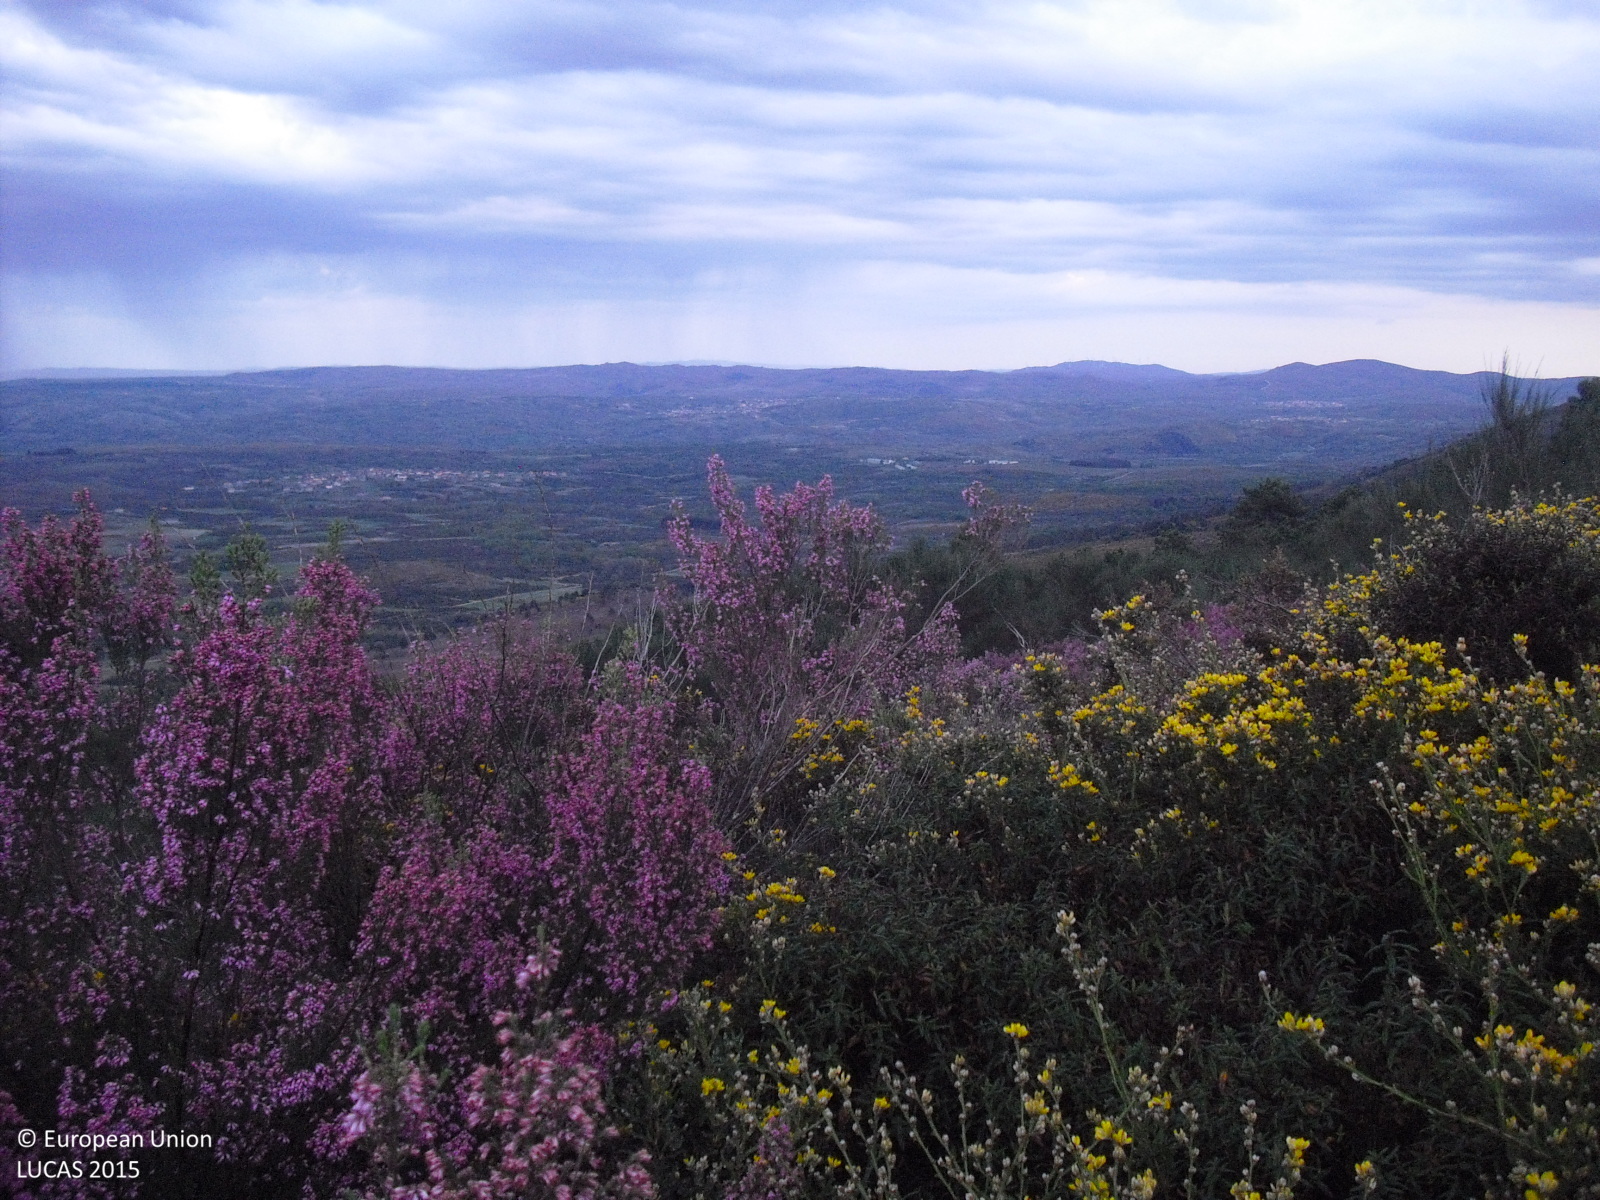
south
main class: Shrubland
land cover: Shrubland without tree cover
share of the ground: > 75 %
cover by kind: shrubs 70 %, herbaceous plants 15 %, consolidated bare surface 15 %
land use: Forestry
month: April
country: ES
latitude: 41.9357
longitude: -7.6624
